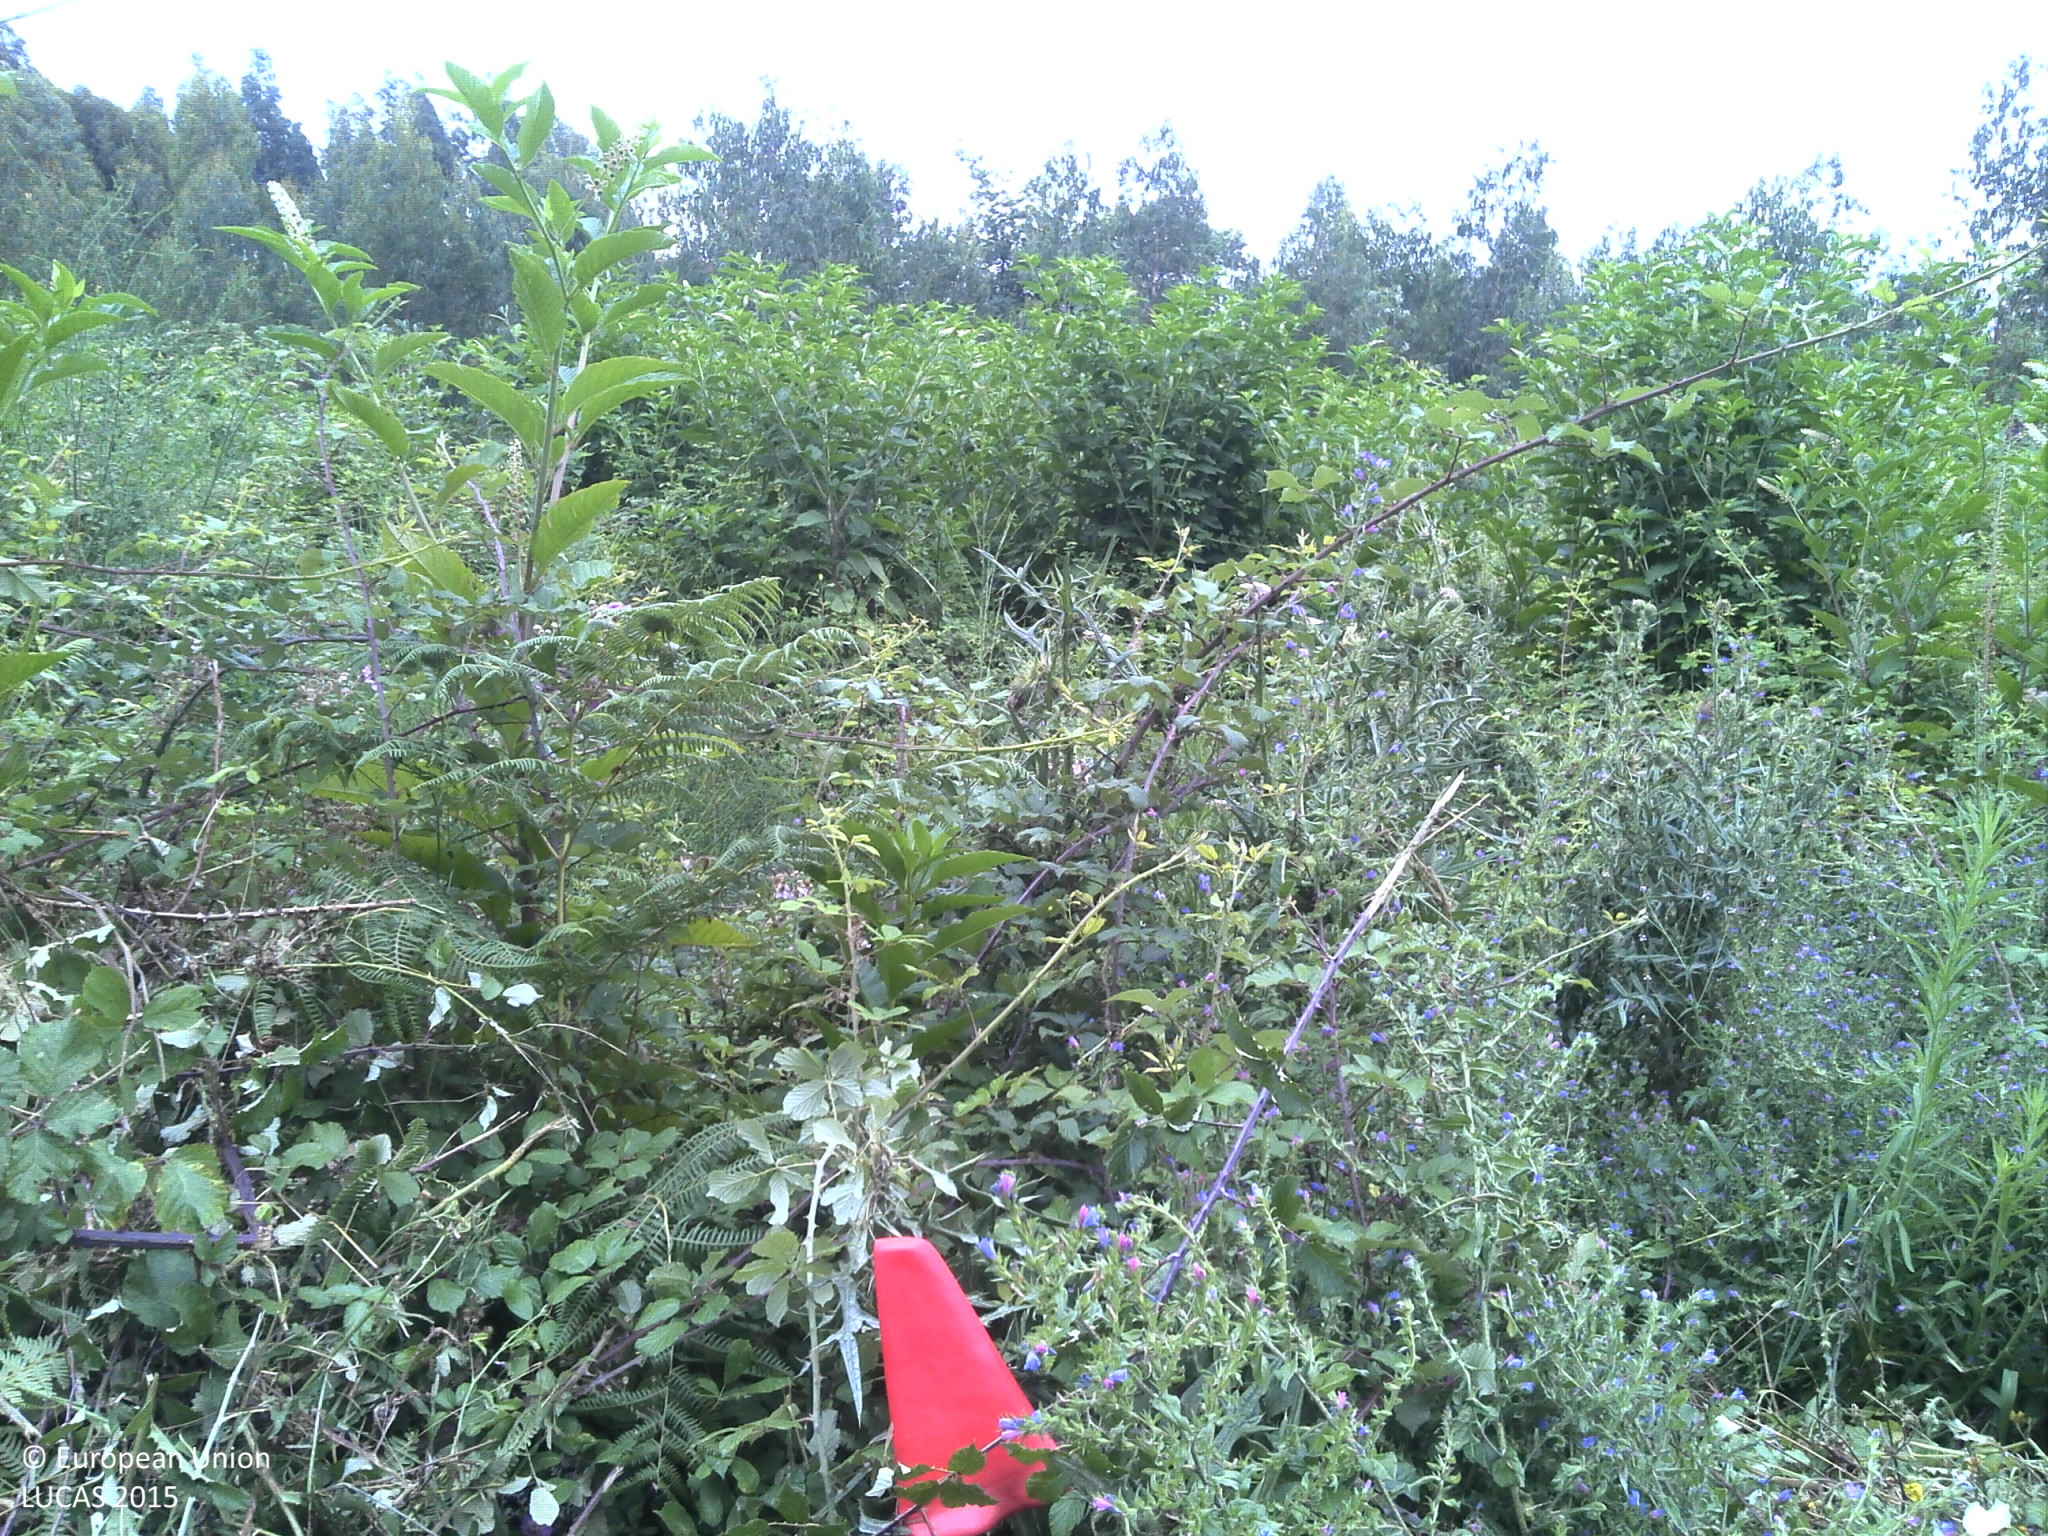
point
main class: Shrubland
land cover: Shrubland without tree cover
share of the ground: > 75 %
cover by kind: shrubs 90 %, unconsolidated bare surface 10 %
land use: Forestry
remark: Clear cut
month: June
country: PT
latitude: 40.7539
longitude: -8.4649
